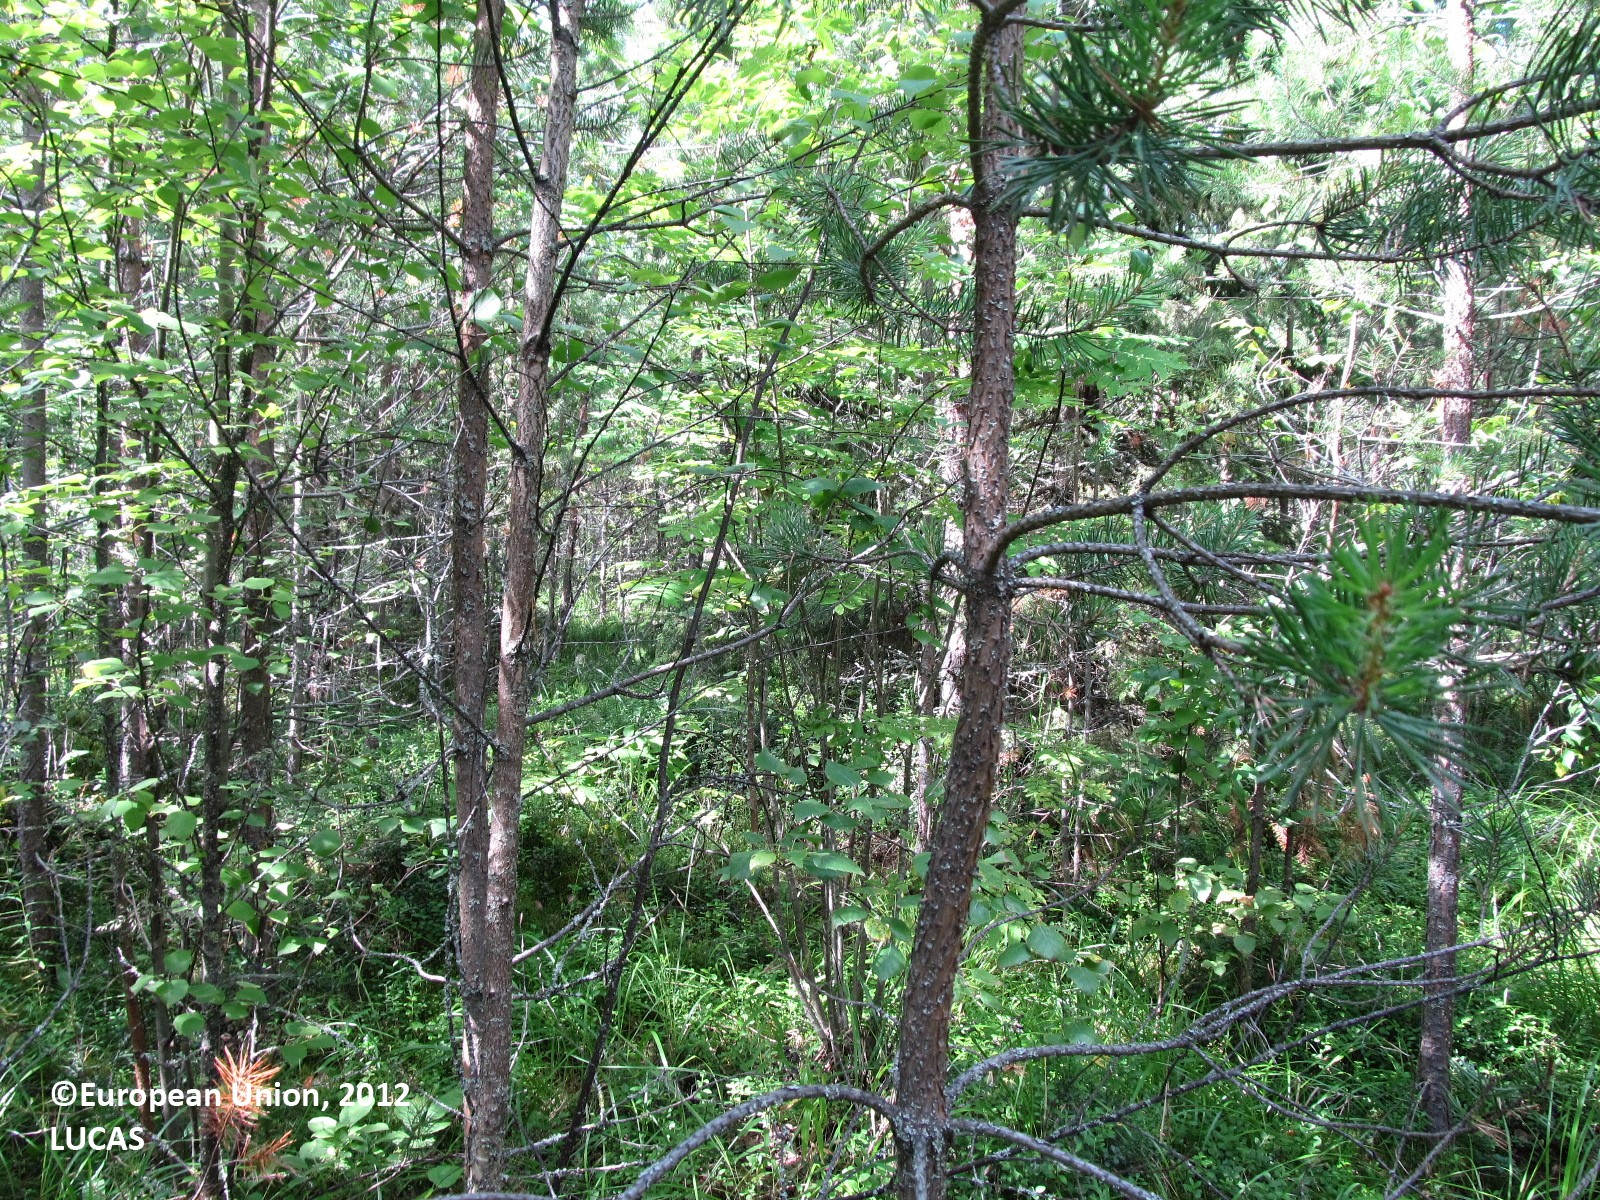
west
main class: Woodland
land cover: Pine dominated mixed woodland
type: boreal forest
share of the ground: 50 - 75 %
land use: Forestry
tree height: > 5 m
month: July
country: FI
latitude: 62.0221
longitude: 27.9377
